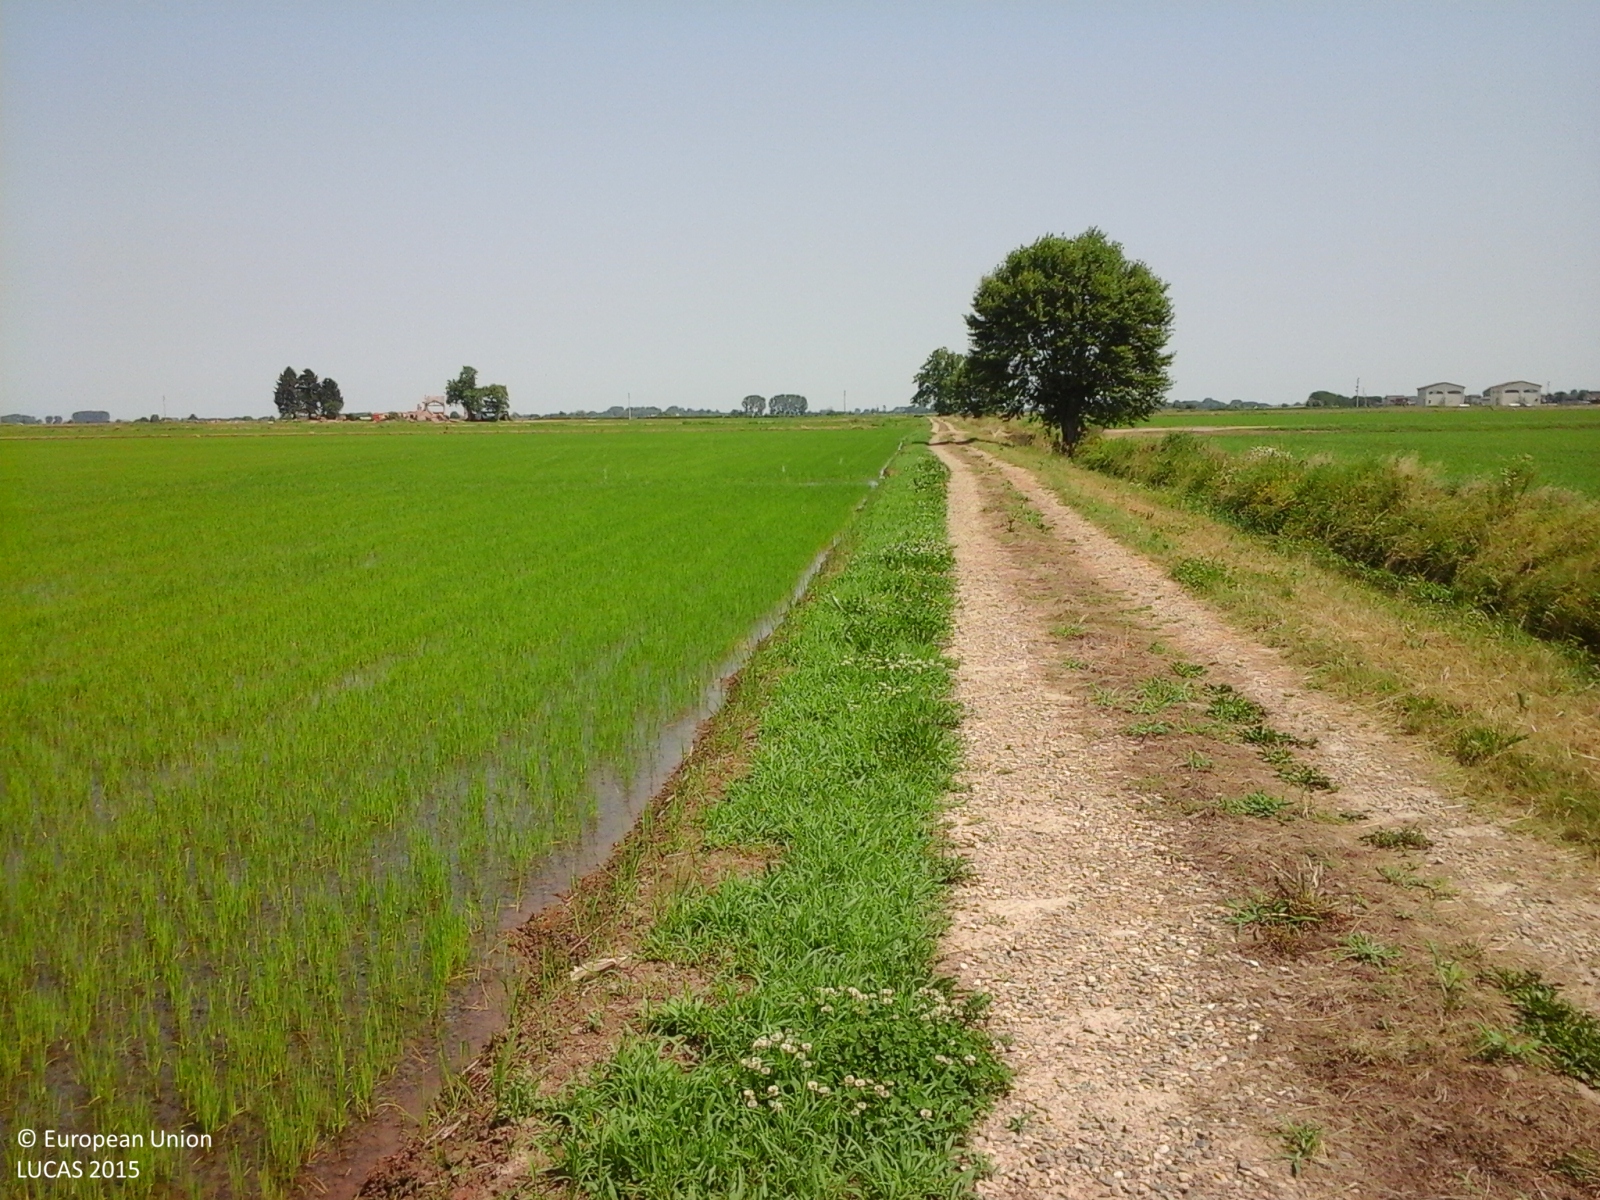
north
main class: Cropland
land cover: Rice
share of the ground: 25 - 50 %
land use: Agriculture (excluding fallow land and kitchen gardens)
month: June
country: IT
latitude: 45.2224
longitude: 8.4363
